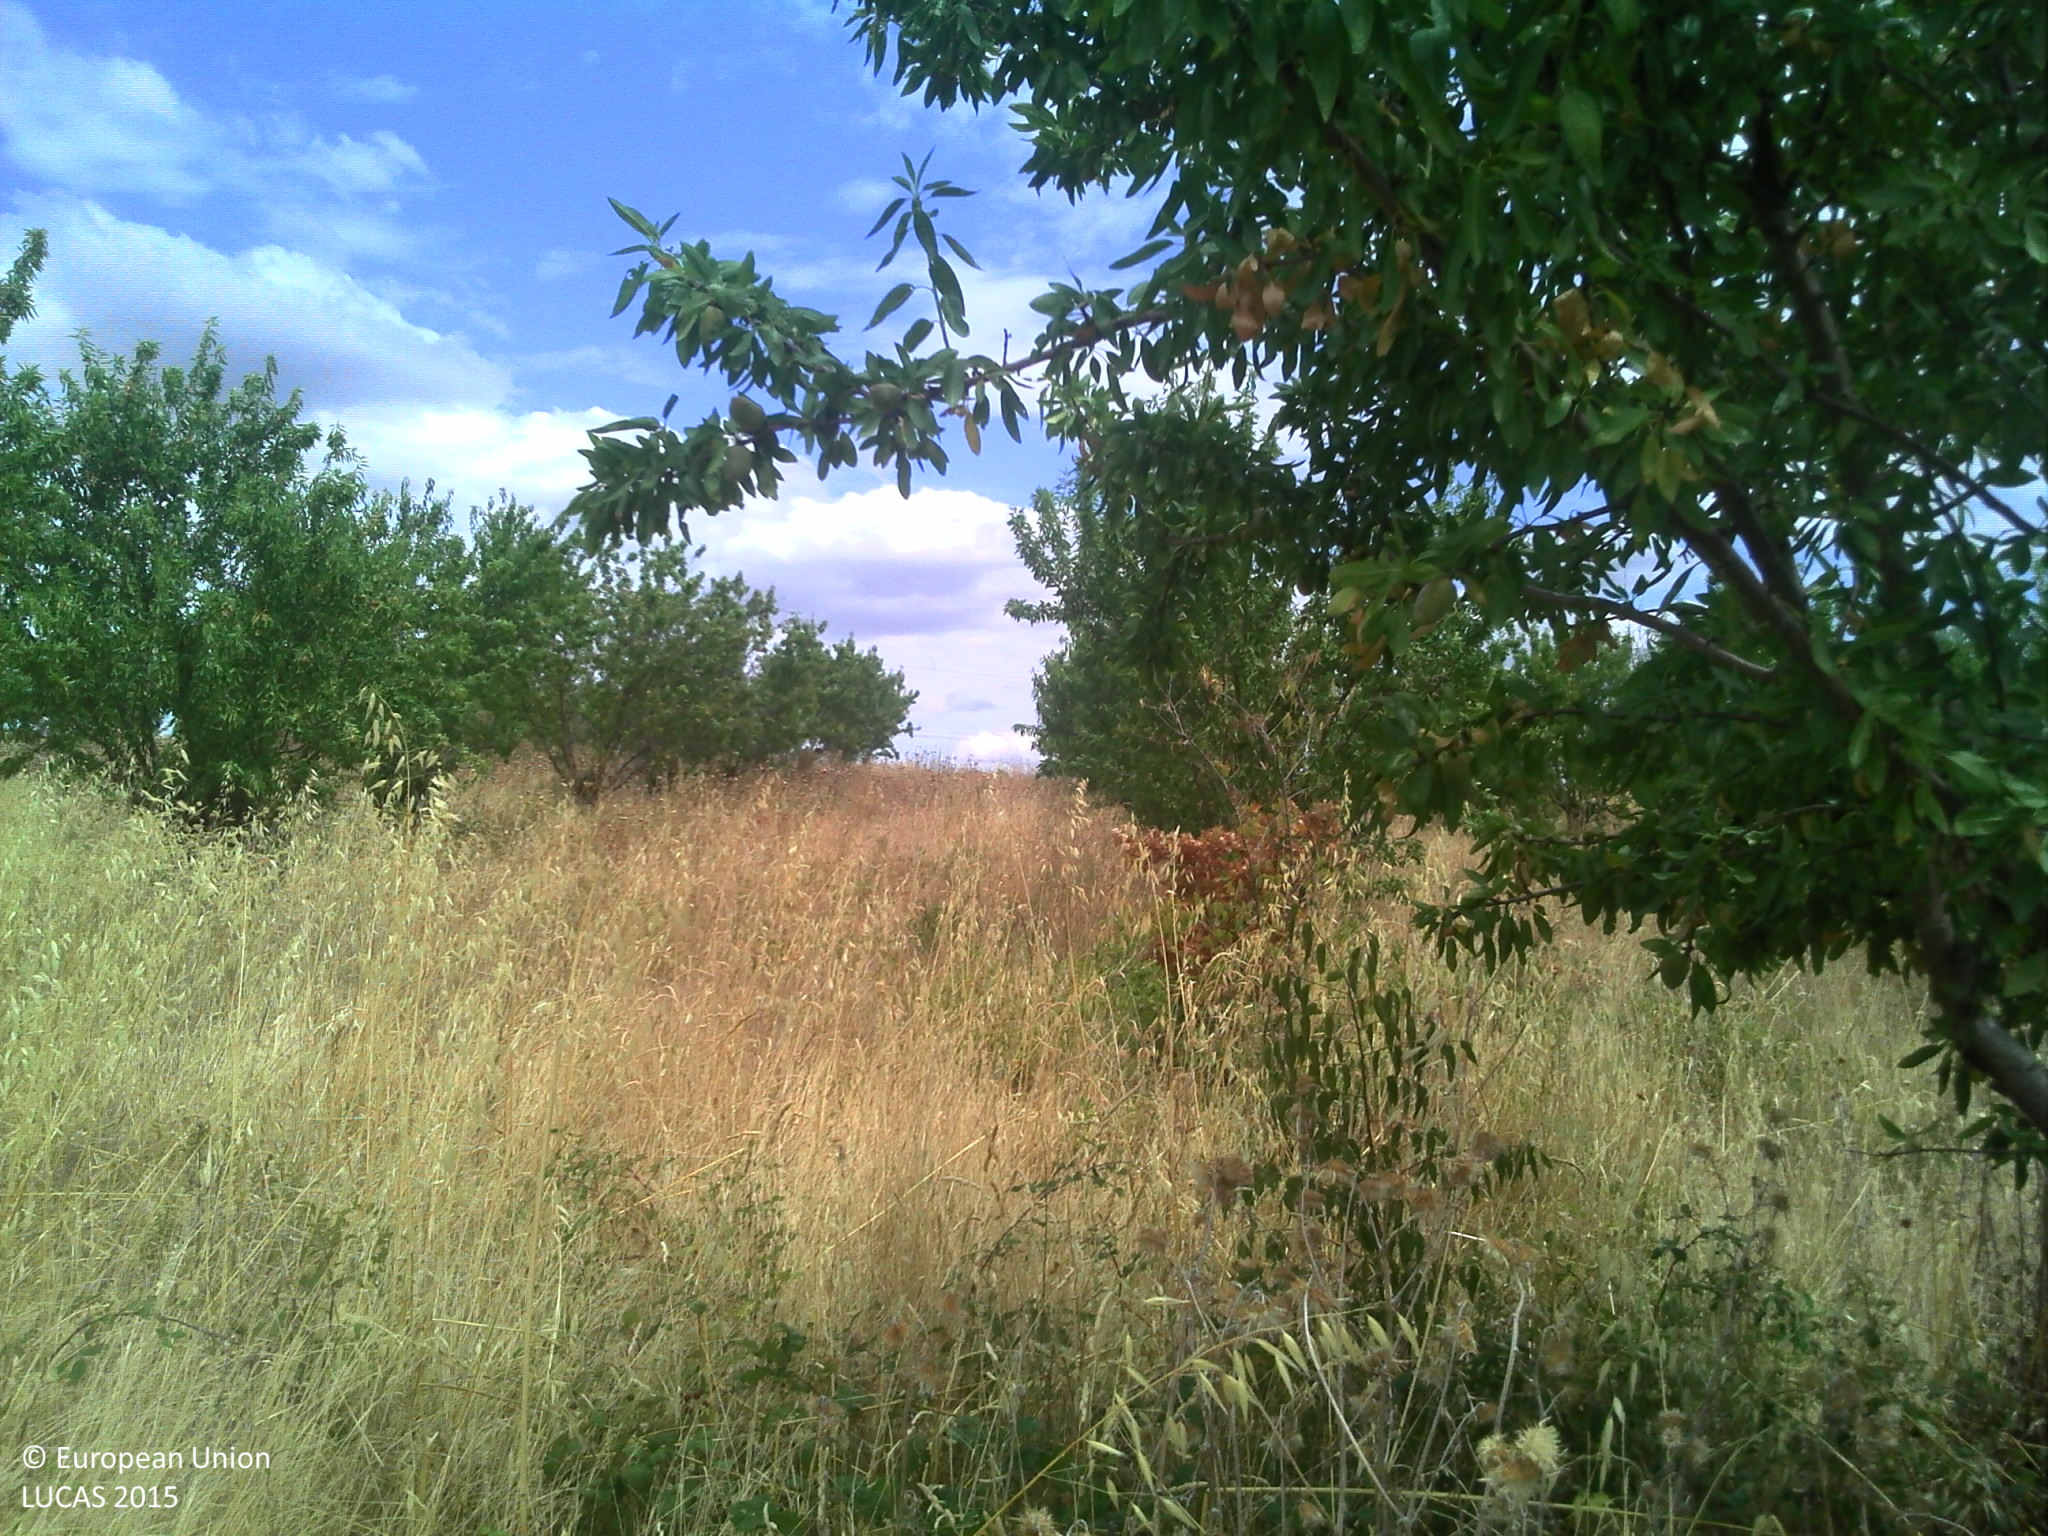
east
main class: Cropland
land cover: Nuts trees
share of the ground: 25 - 50 %
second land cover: Spontaneously vegetated surfaces
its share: > 75 %
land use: Agriculture (excluding fallow land and kitchen gardens)
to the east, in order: Nuts trees; Spontaneously vegetated surfaces; Shrubland without tree cover; Paved roads, cycling and walking lanes; Electric lines; Tracks; Vineyards; Tracks; Shrubland with sparse tree cover; Vineyards; Shruby margins; Tracks; Vineyards
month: July
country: FR
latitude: 43.4527
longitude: 3.1254
